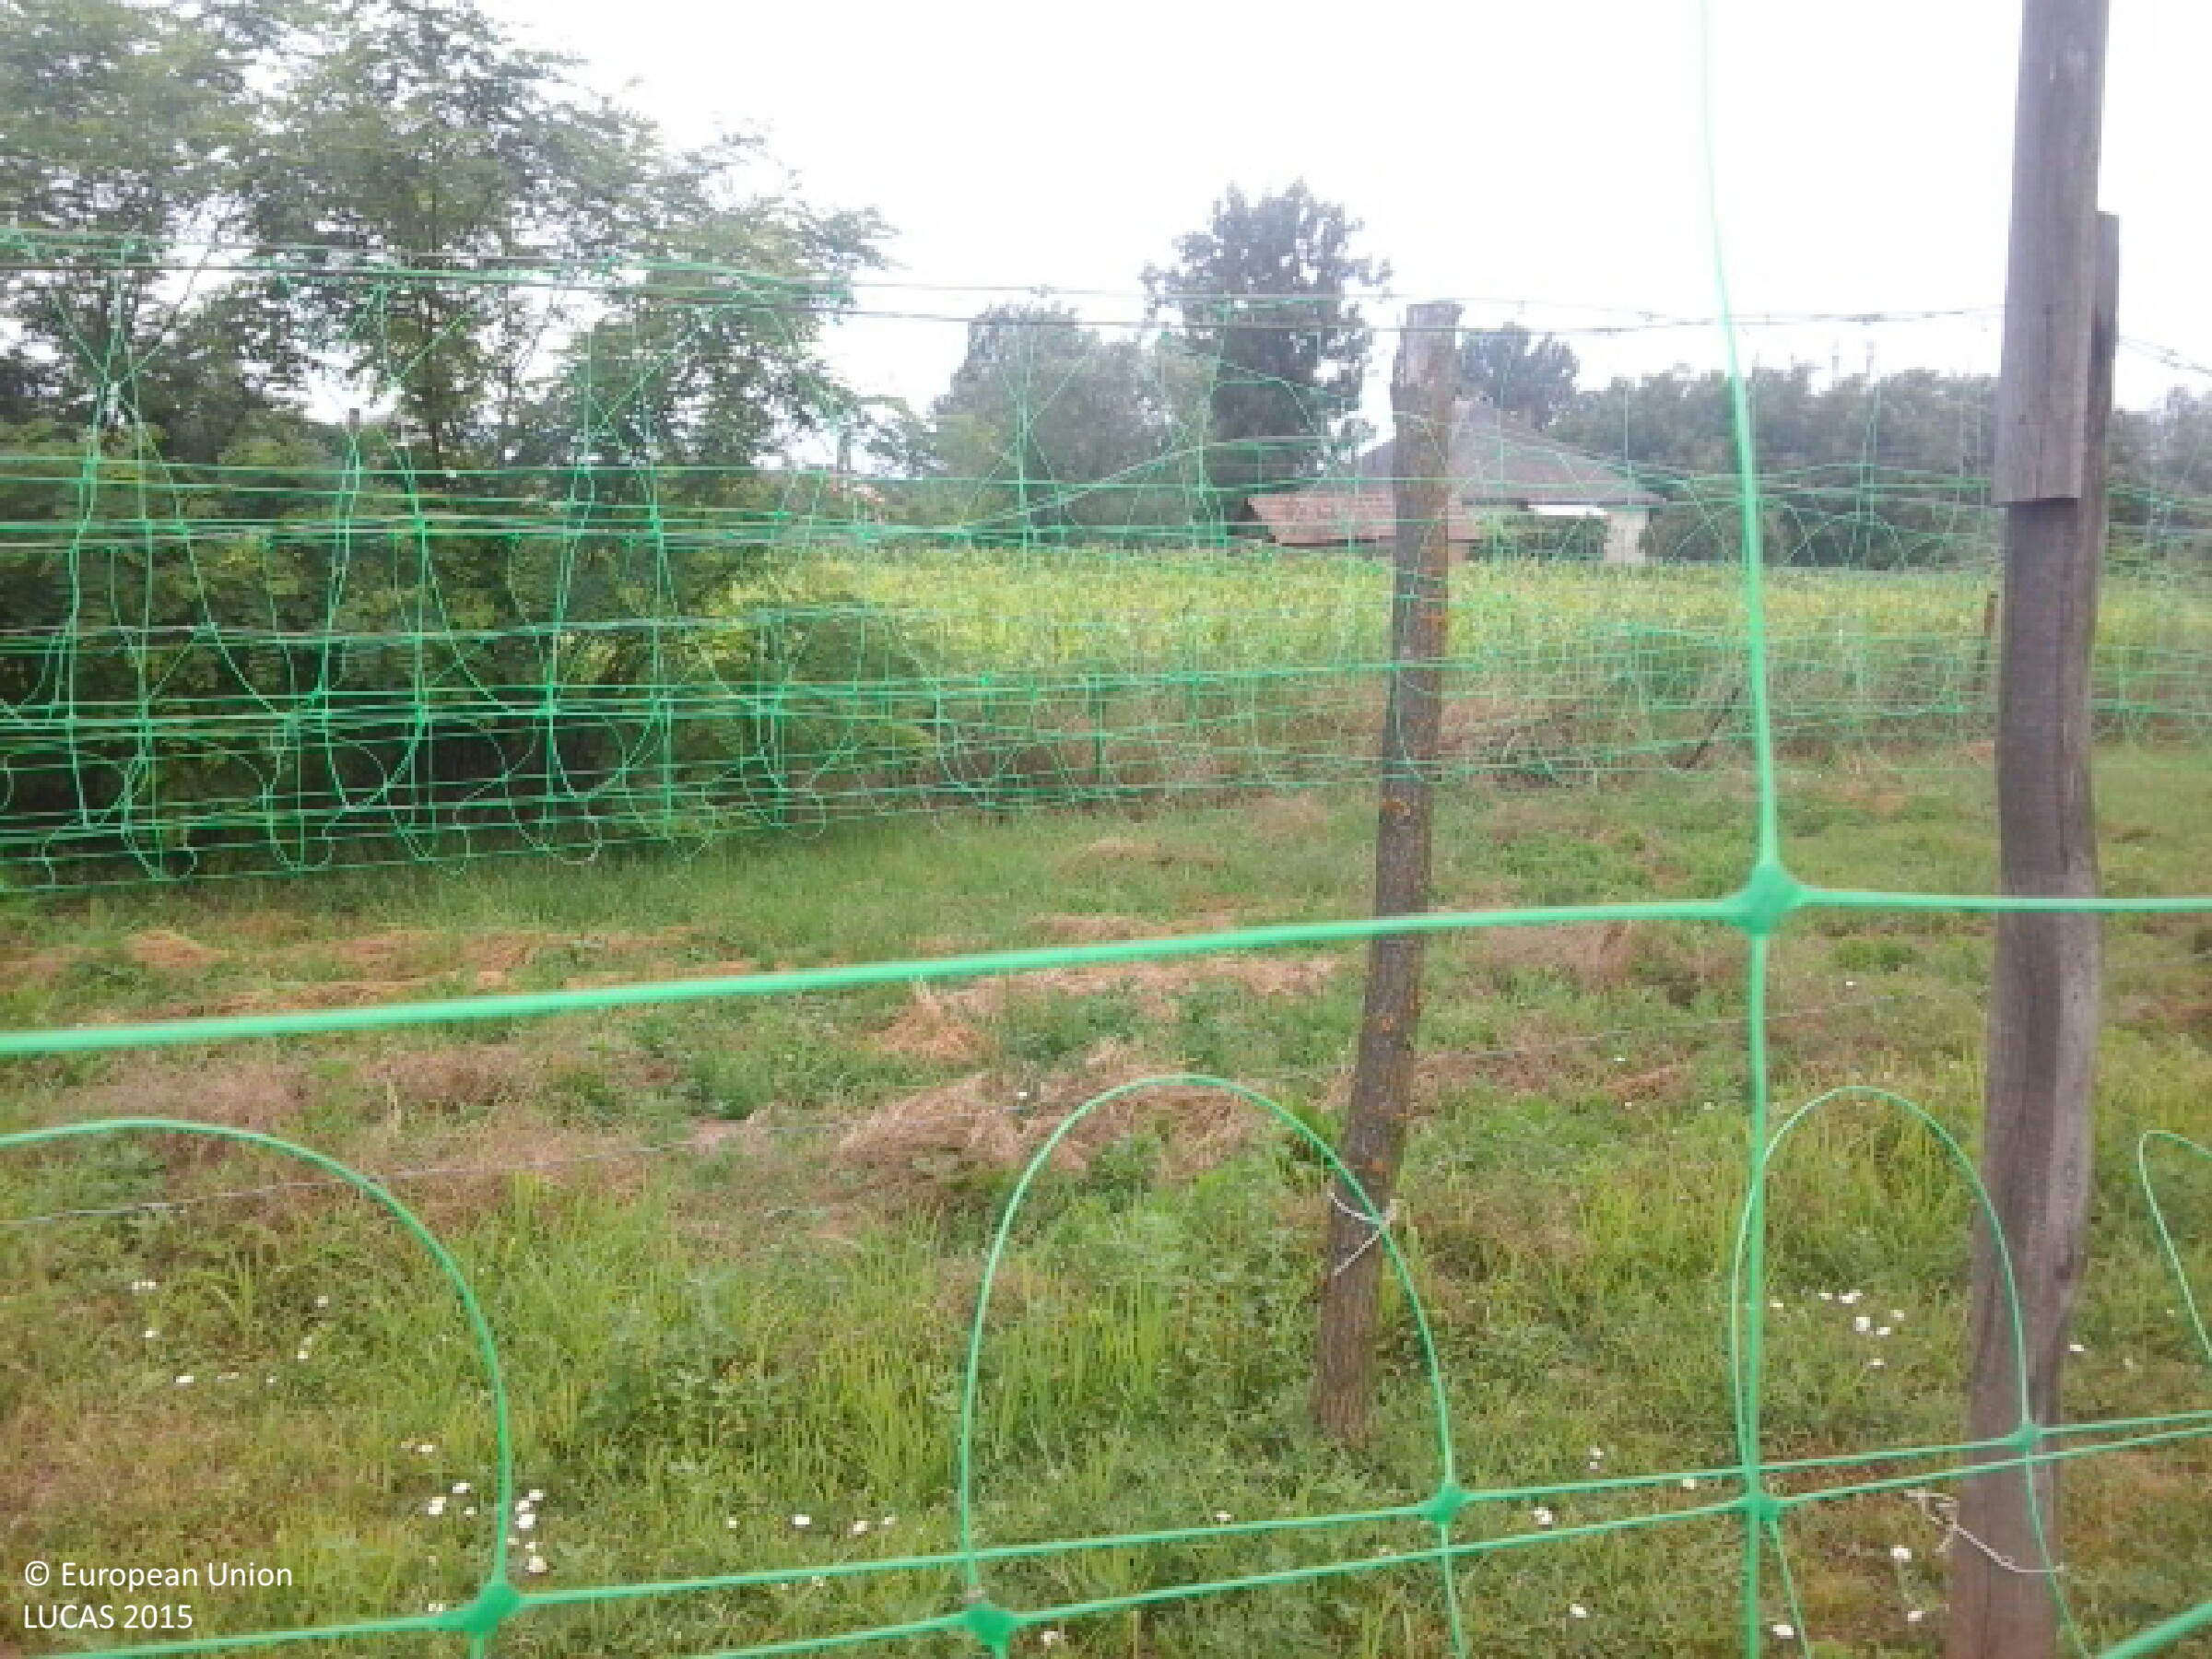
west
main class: Grassland
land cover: Spontaneously vegetated surfaces
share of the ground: > 75 %
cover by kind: herbaceous plants 100 %
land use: Fallow land
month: June
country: HU
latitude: 47.9820
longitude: 22.1797
